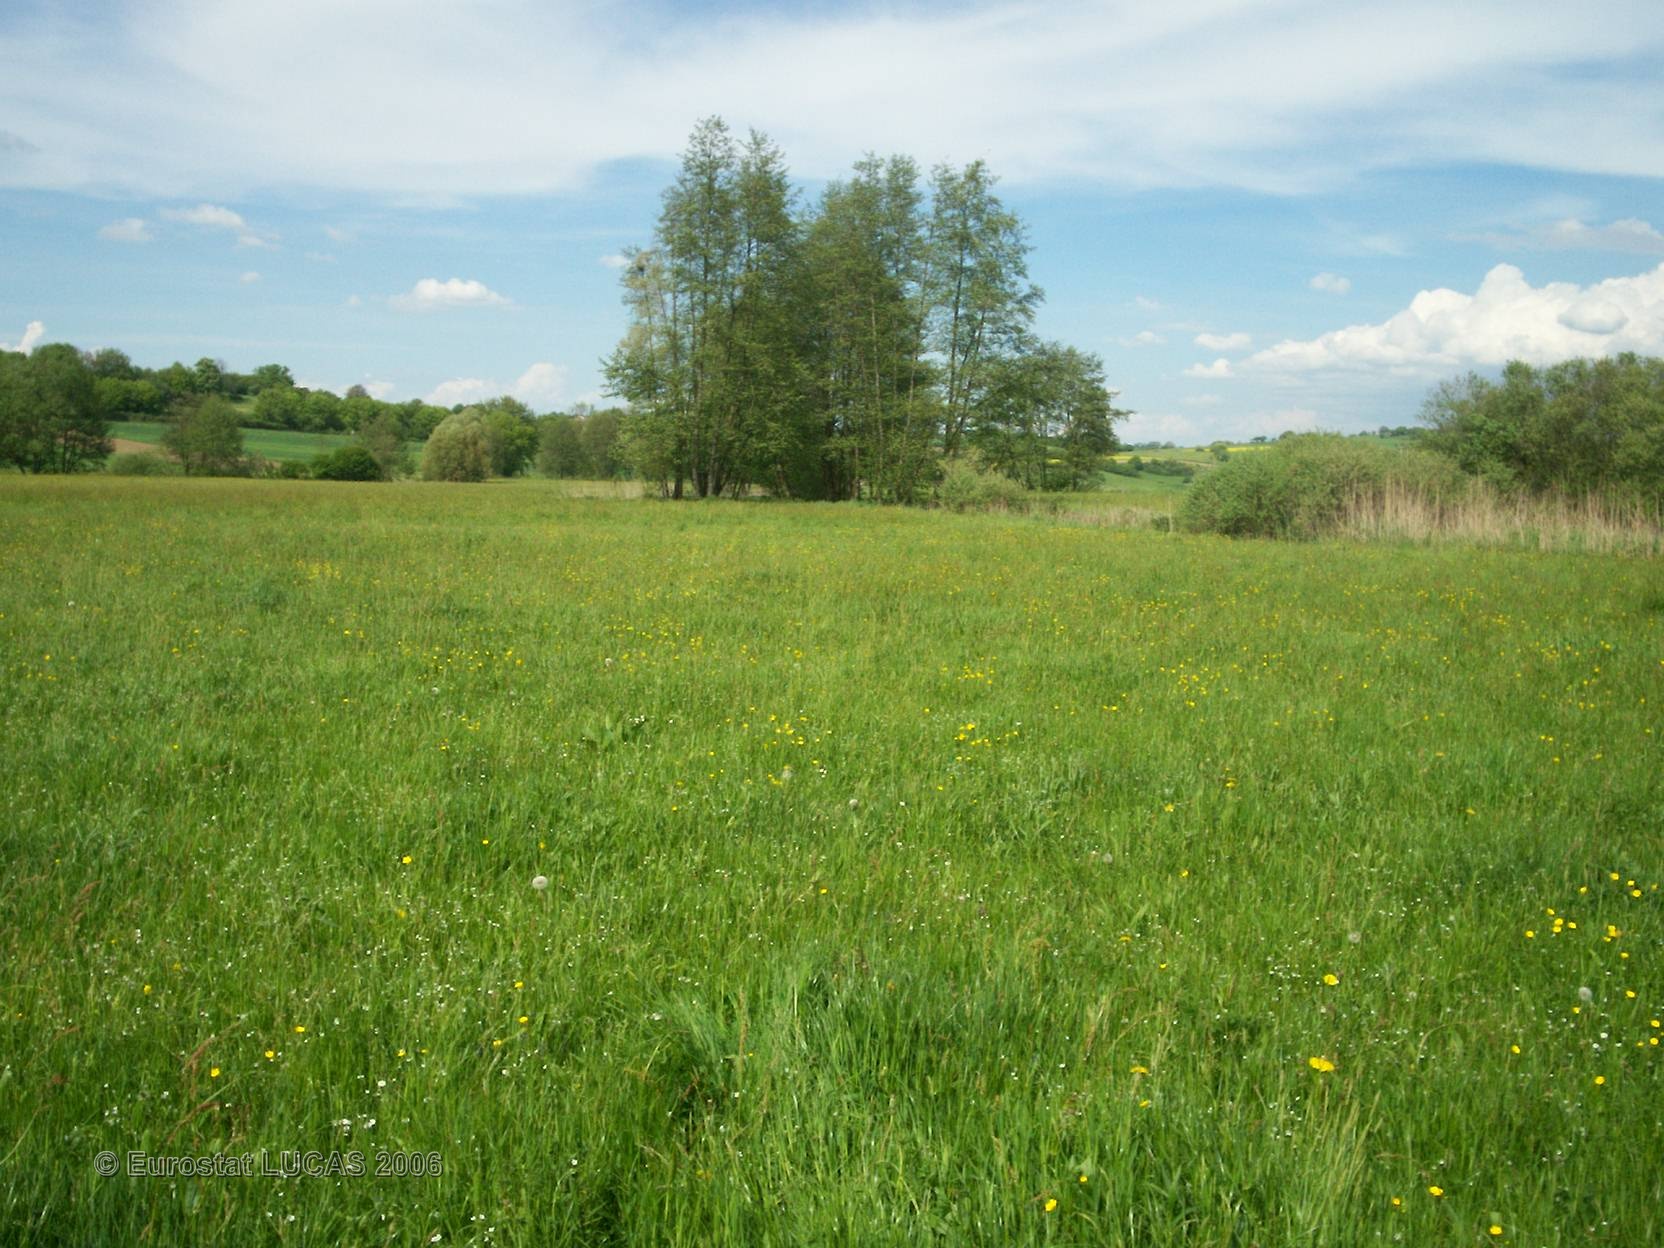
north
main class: Grassland
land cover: Grassland without tree/shrub cover
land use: Agriculture (excluding fallow land and kitchen gardens)
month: May
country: FR
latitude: 48.8328
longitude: 7.0716
